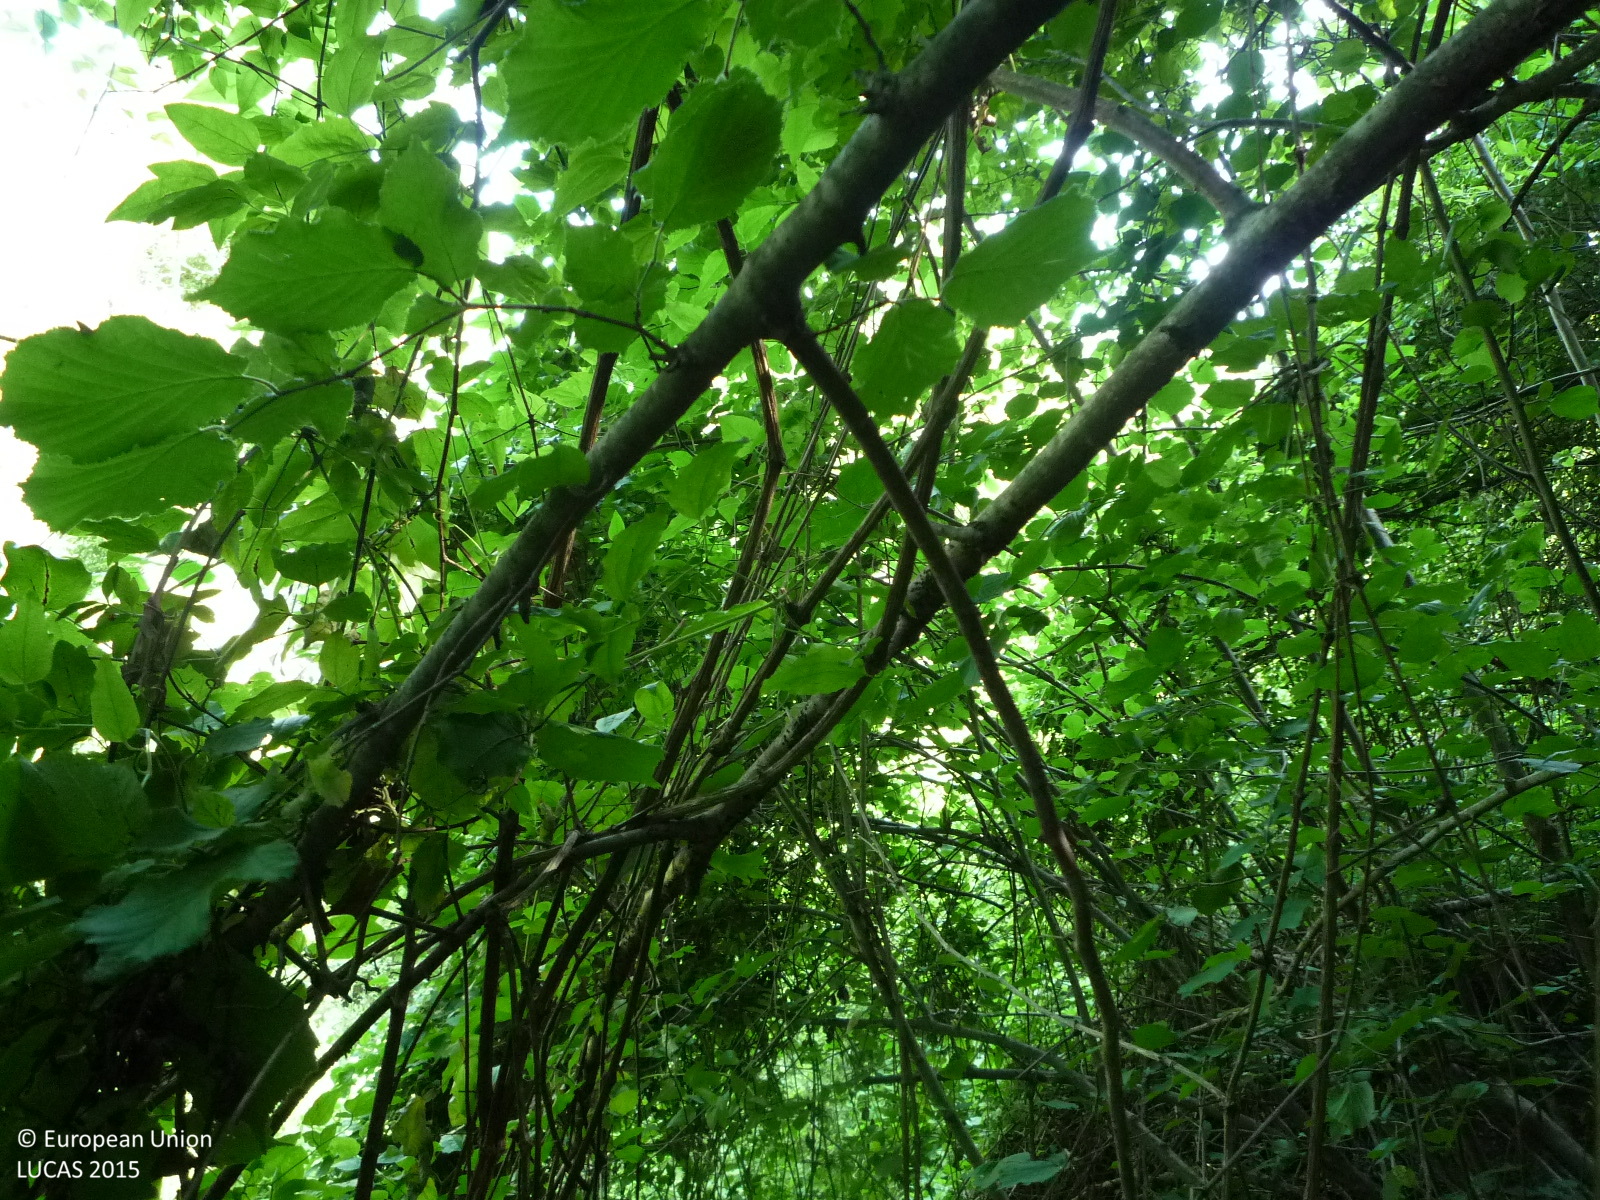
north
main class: Woodland
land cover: Other mixed woodland
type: thermophilous deciduous forest
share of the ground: > 75 %
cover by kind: broadleaved forest trees 75 %, coniferous forest trees 25 %
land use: Forestry
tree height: > 5 m
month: July
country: ES
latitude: 42.1312
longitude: 1.9196
